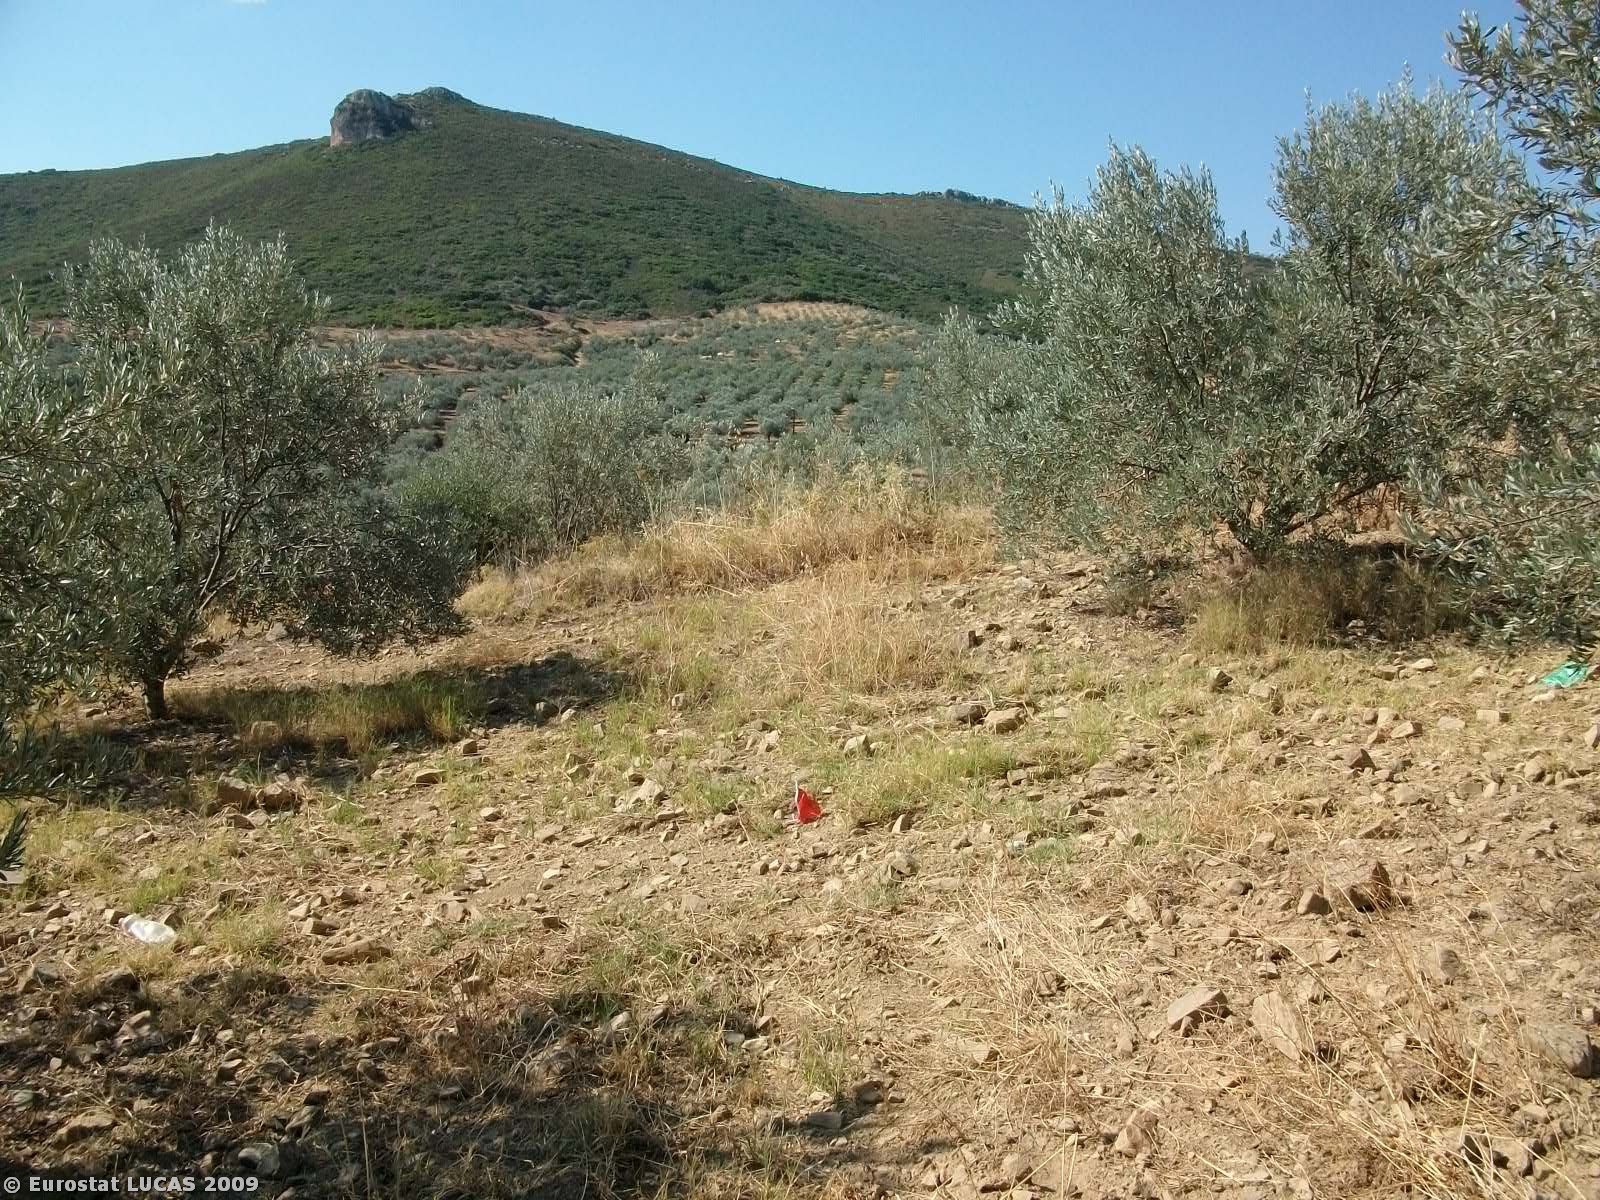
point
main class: Cropland
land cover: Olive groves
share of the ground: 50 - 75 %
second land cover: Grassland with sparse tree/shrub cover
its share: 50 - 75 %
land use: Agriculture (excluding fallow land and kitchen gardens)
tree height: < 5 m
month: July
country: GR
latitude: 37.6146
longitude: 22.9163
